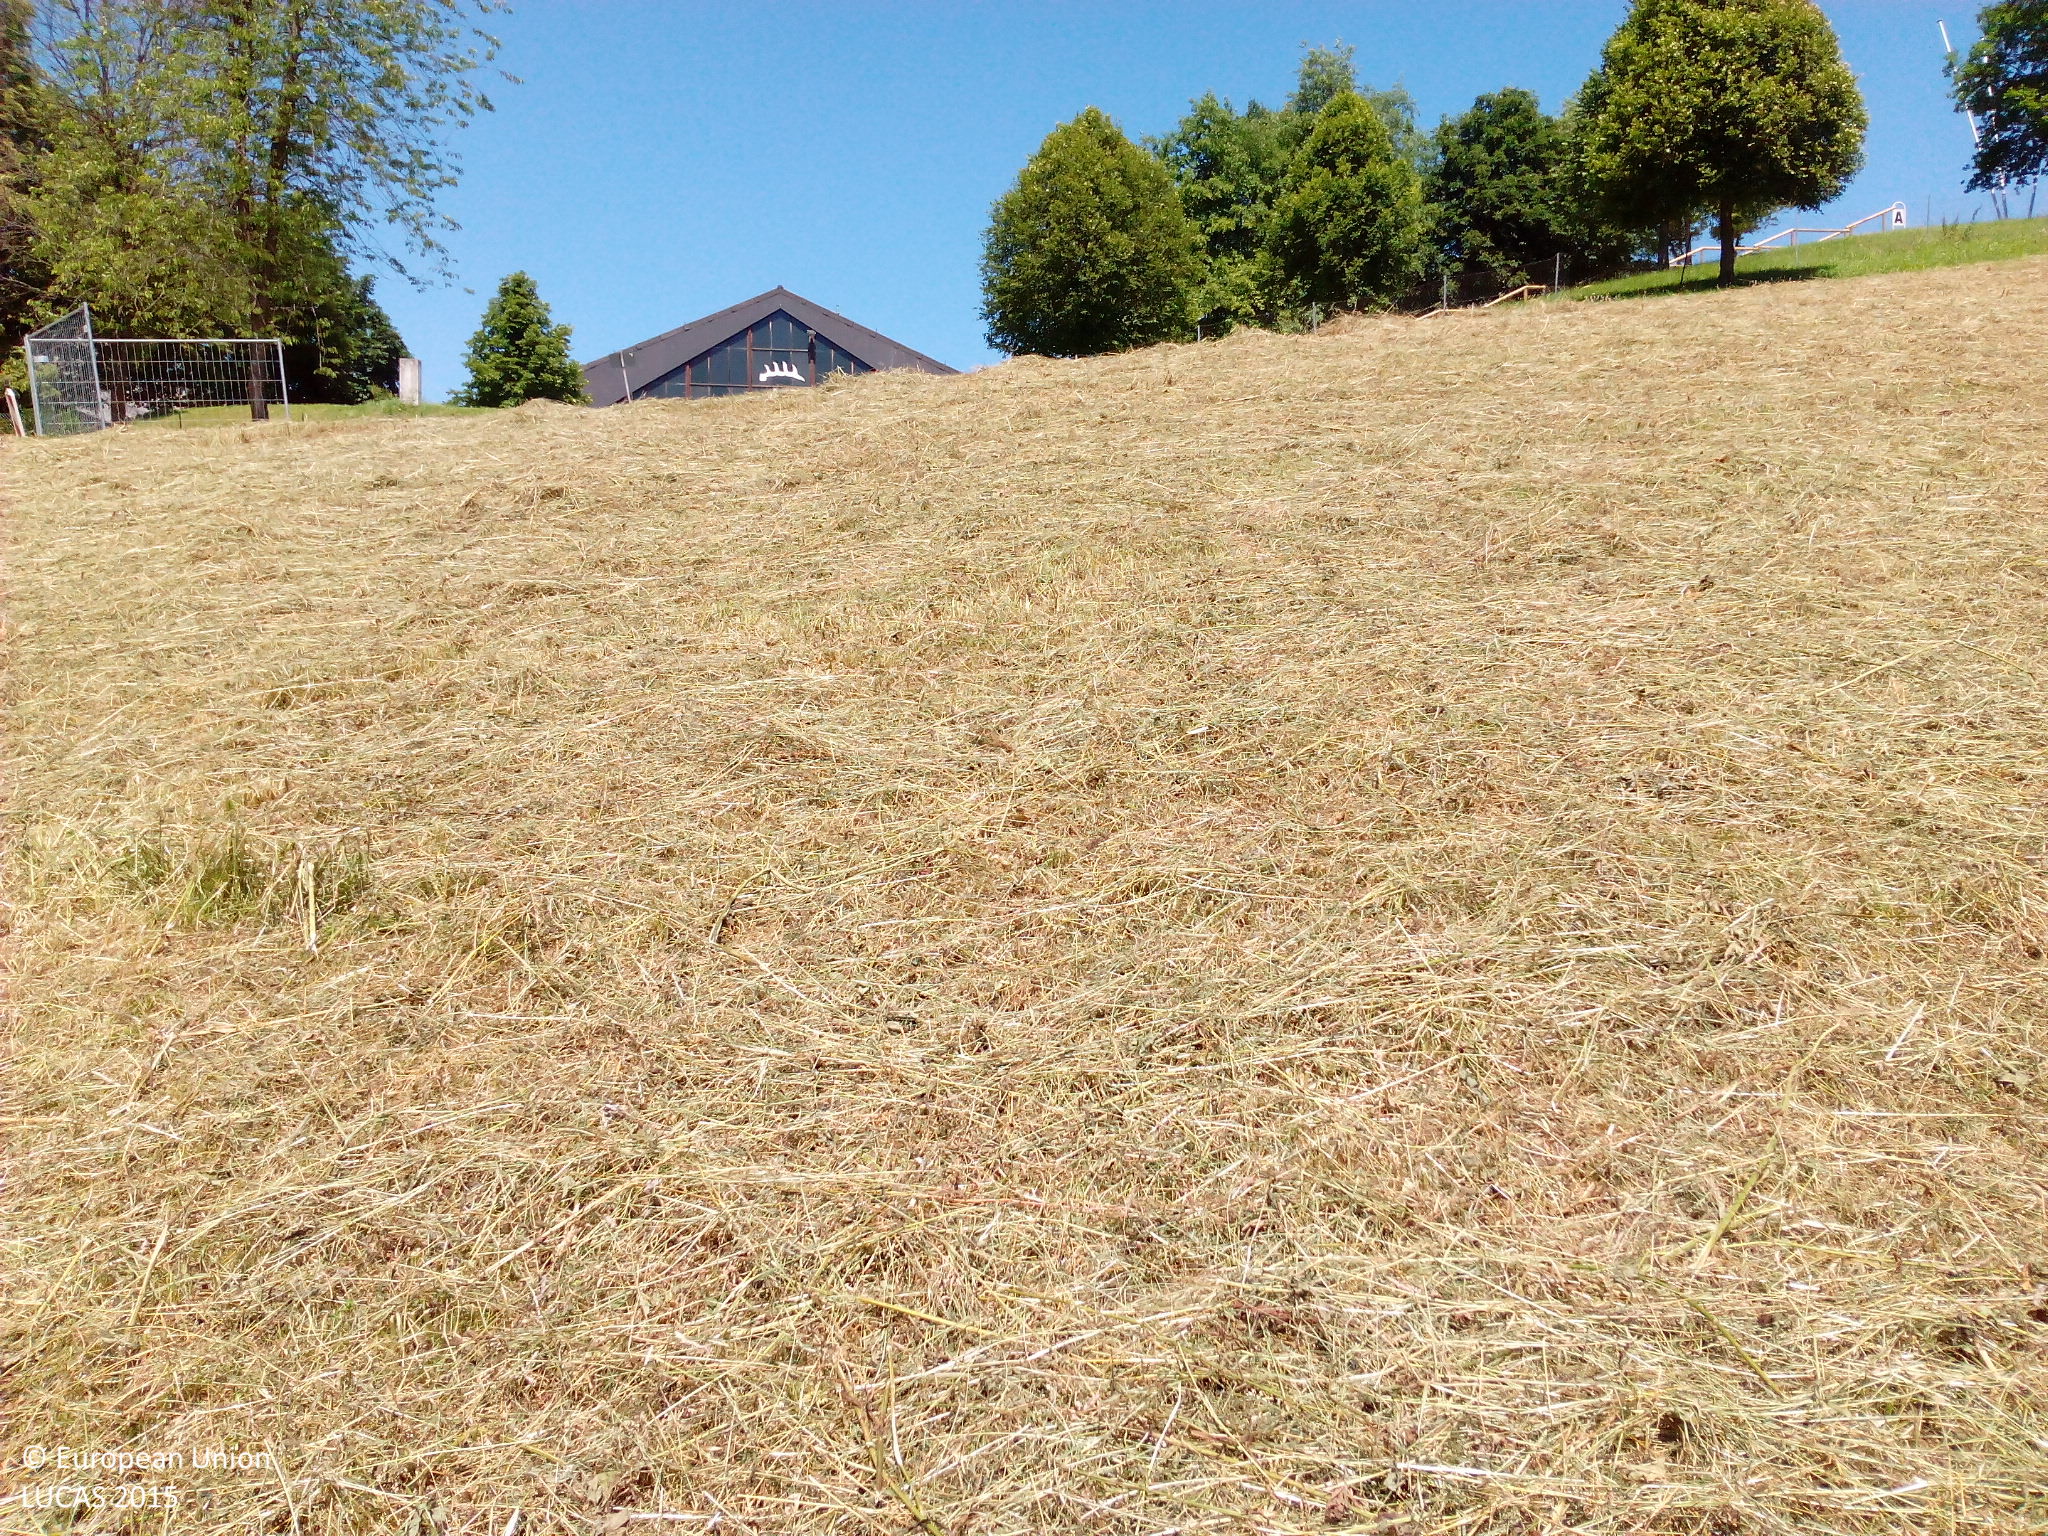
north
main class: Grassland
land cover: Grassland without tree/shrub cover
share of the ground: > 75 %
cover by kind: herbaceous plants 100 %
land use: Agriculture (excluding fallow land and kitchen gardens)
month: July
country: DE
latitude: 48.3840
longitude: 9.4197
